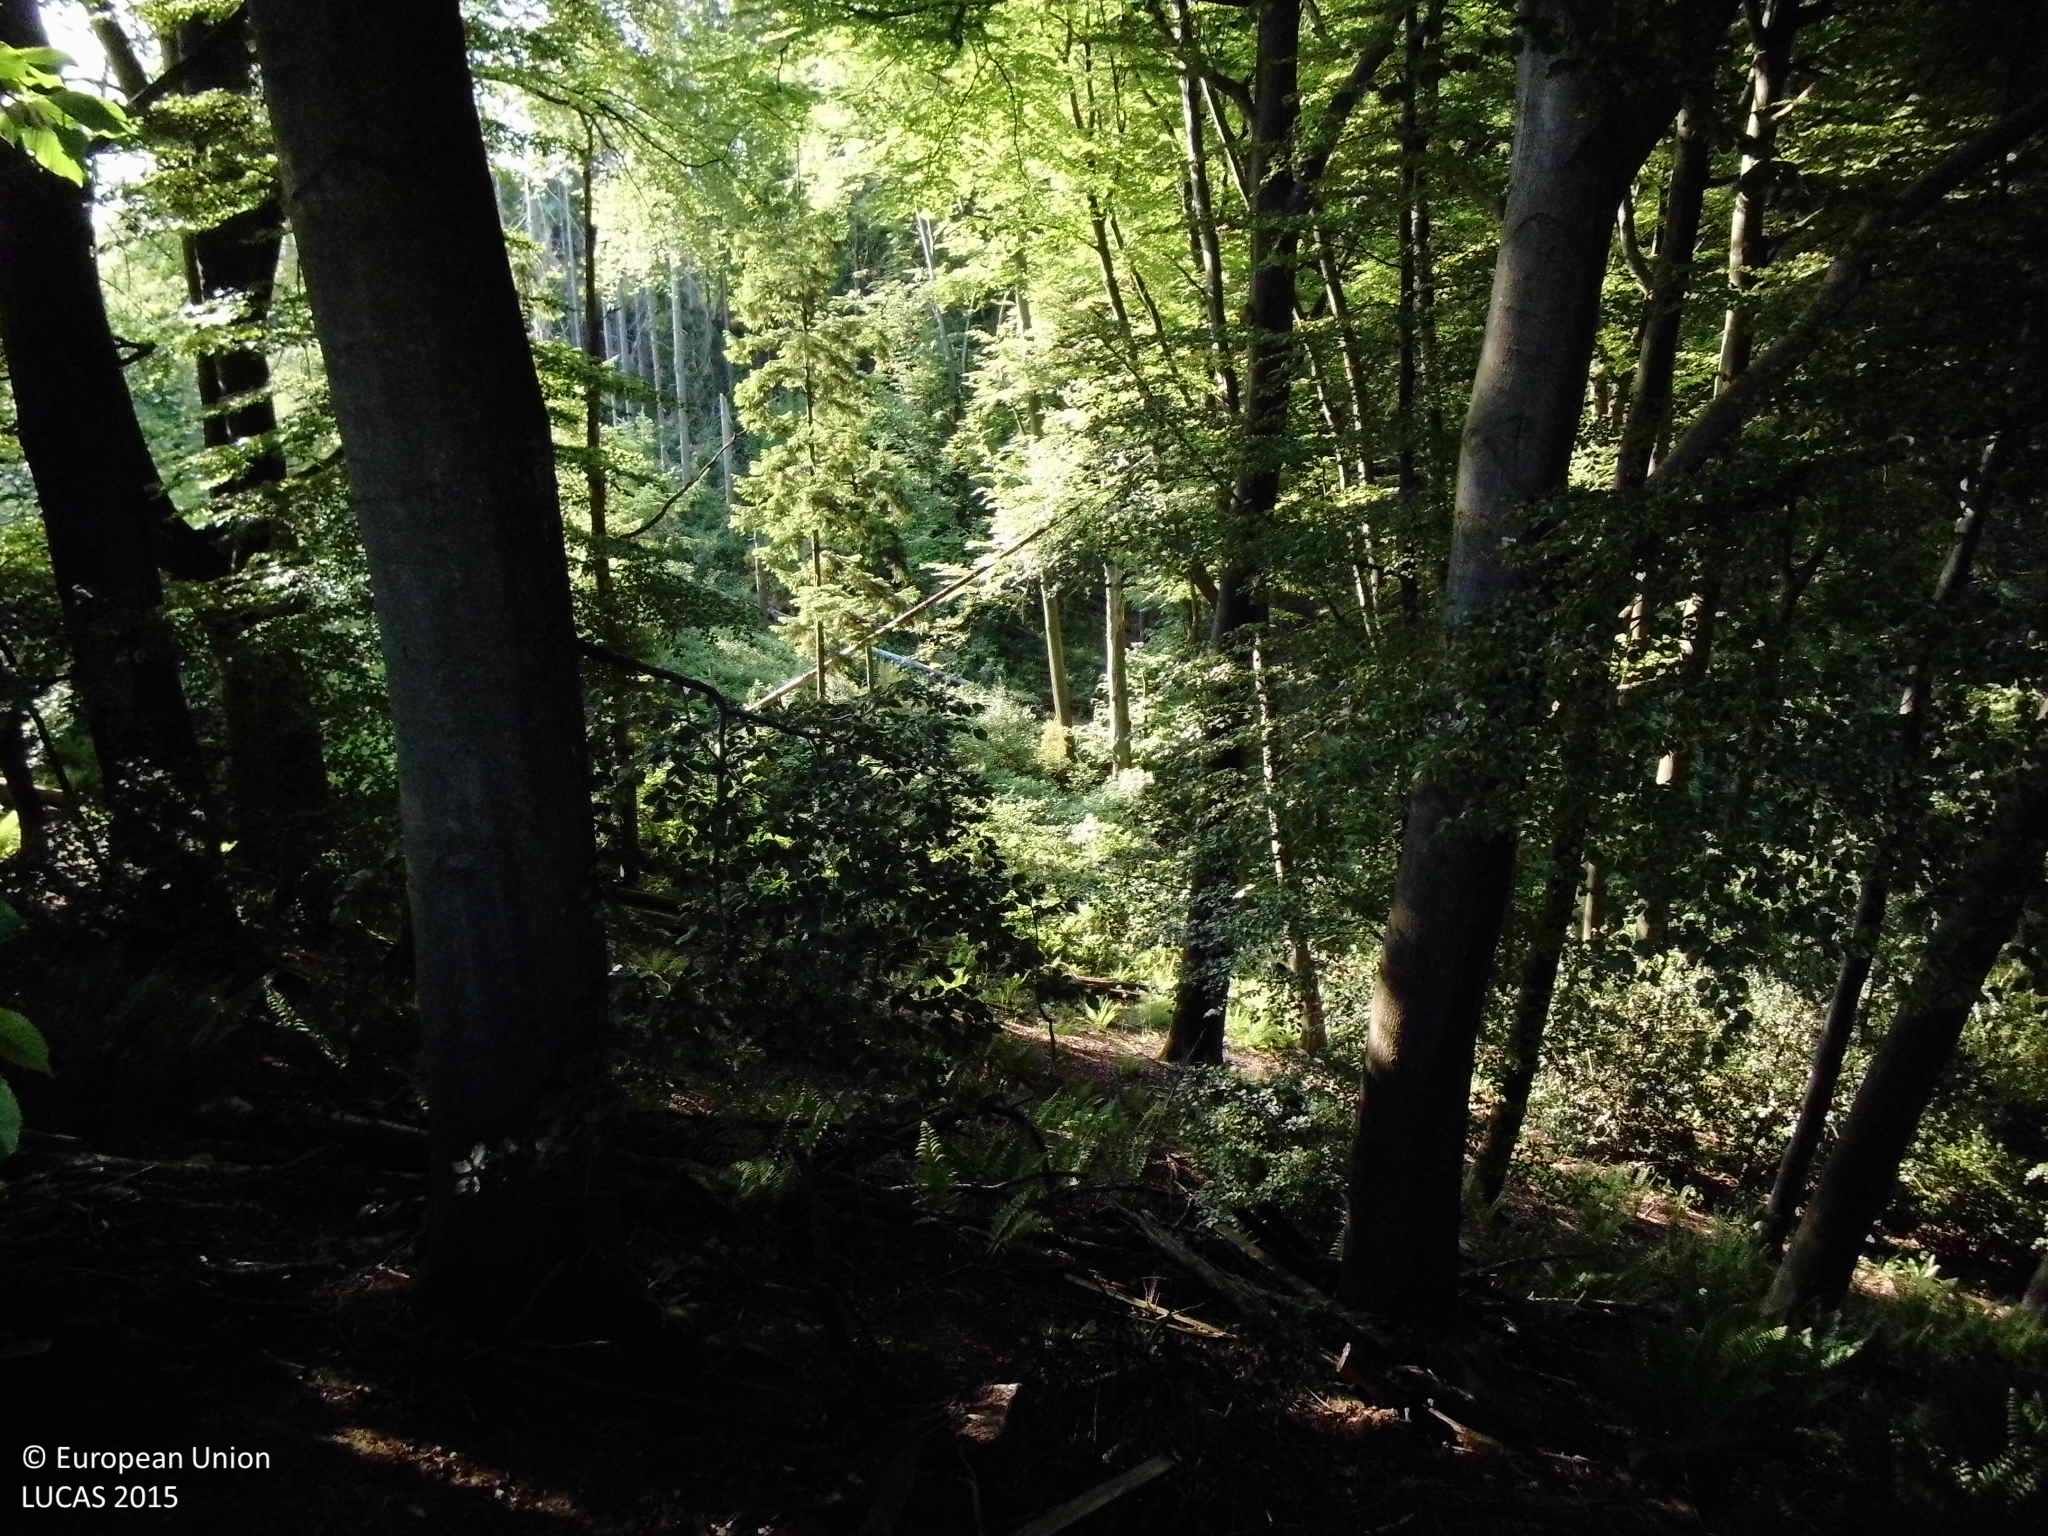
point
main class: Woodland
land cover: Broadleaved woodland
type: mesophytic deciduous forest
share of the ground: > 75 %
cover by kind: broadleaved forest trees 75 %, coniferous forest trees 10 %, shrubs 5 %, herbaceous plants 5 %, unconsolidated bare surface 5 %
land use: Forestry
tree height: > 5 m
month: May
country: DE
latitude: 50.7689
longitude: 7.5189
